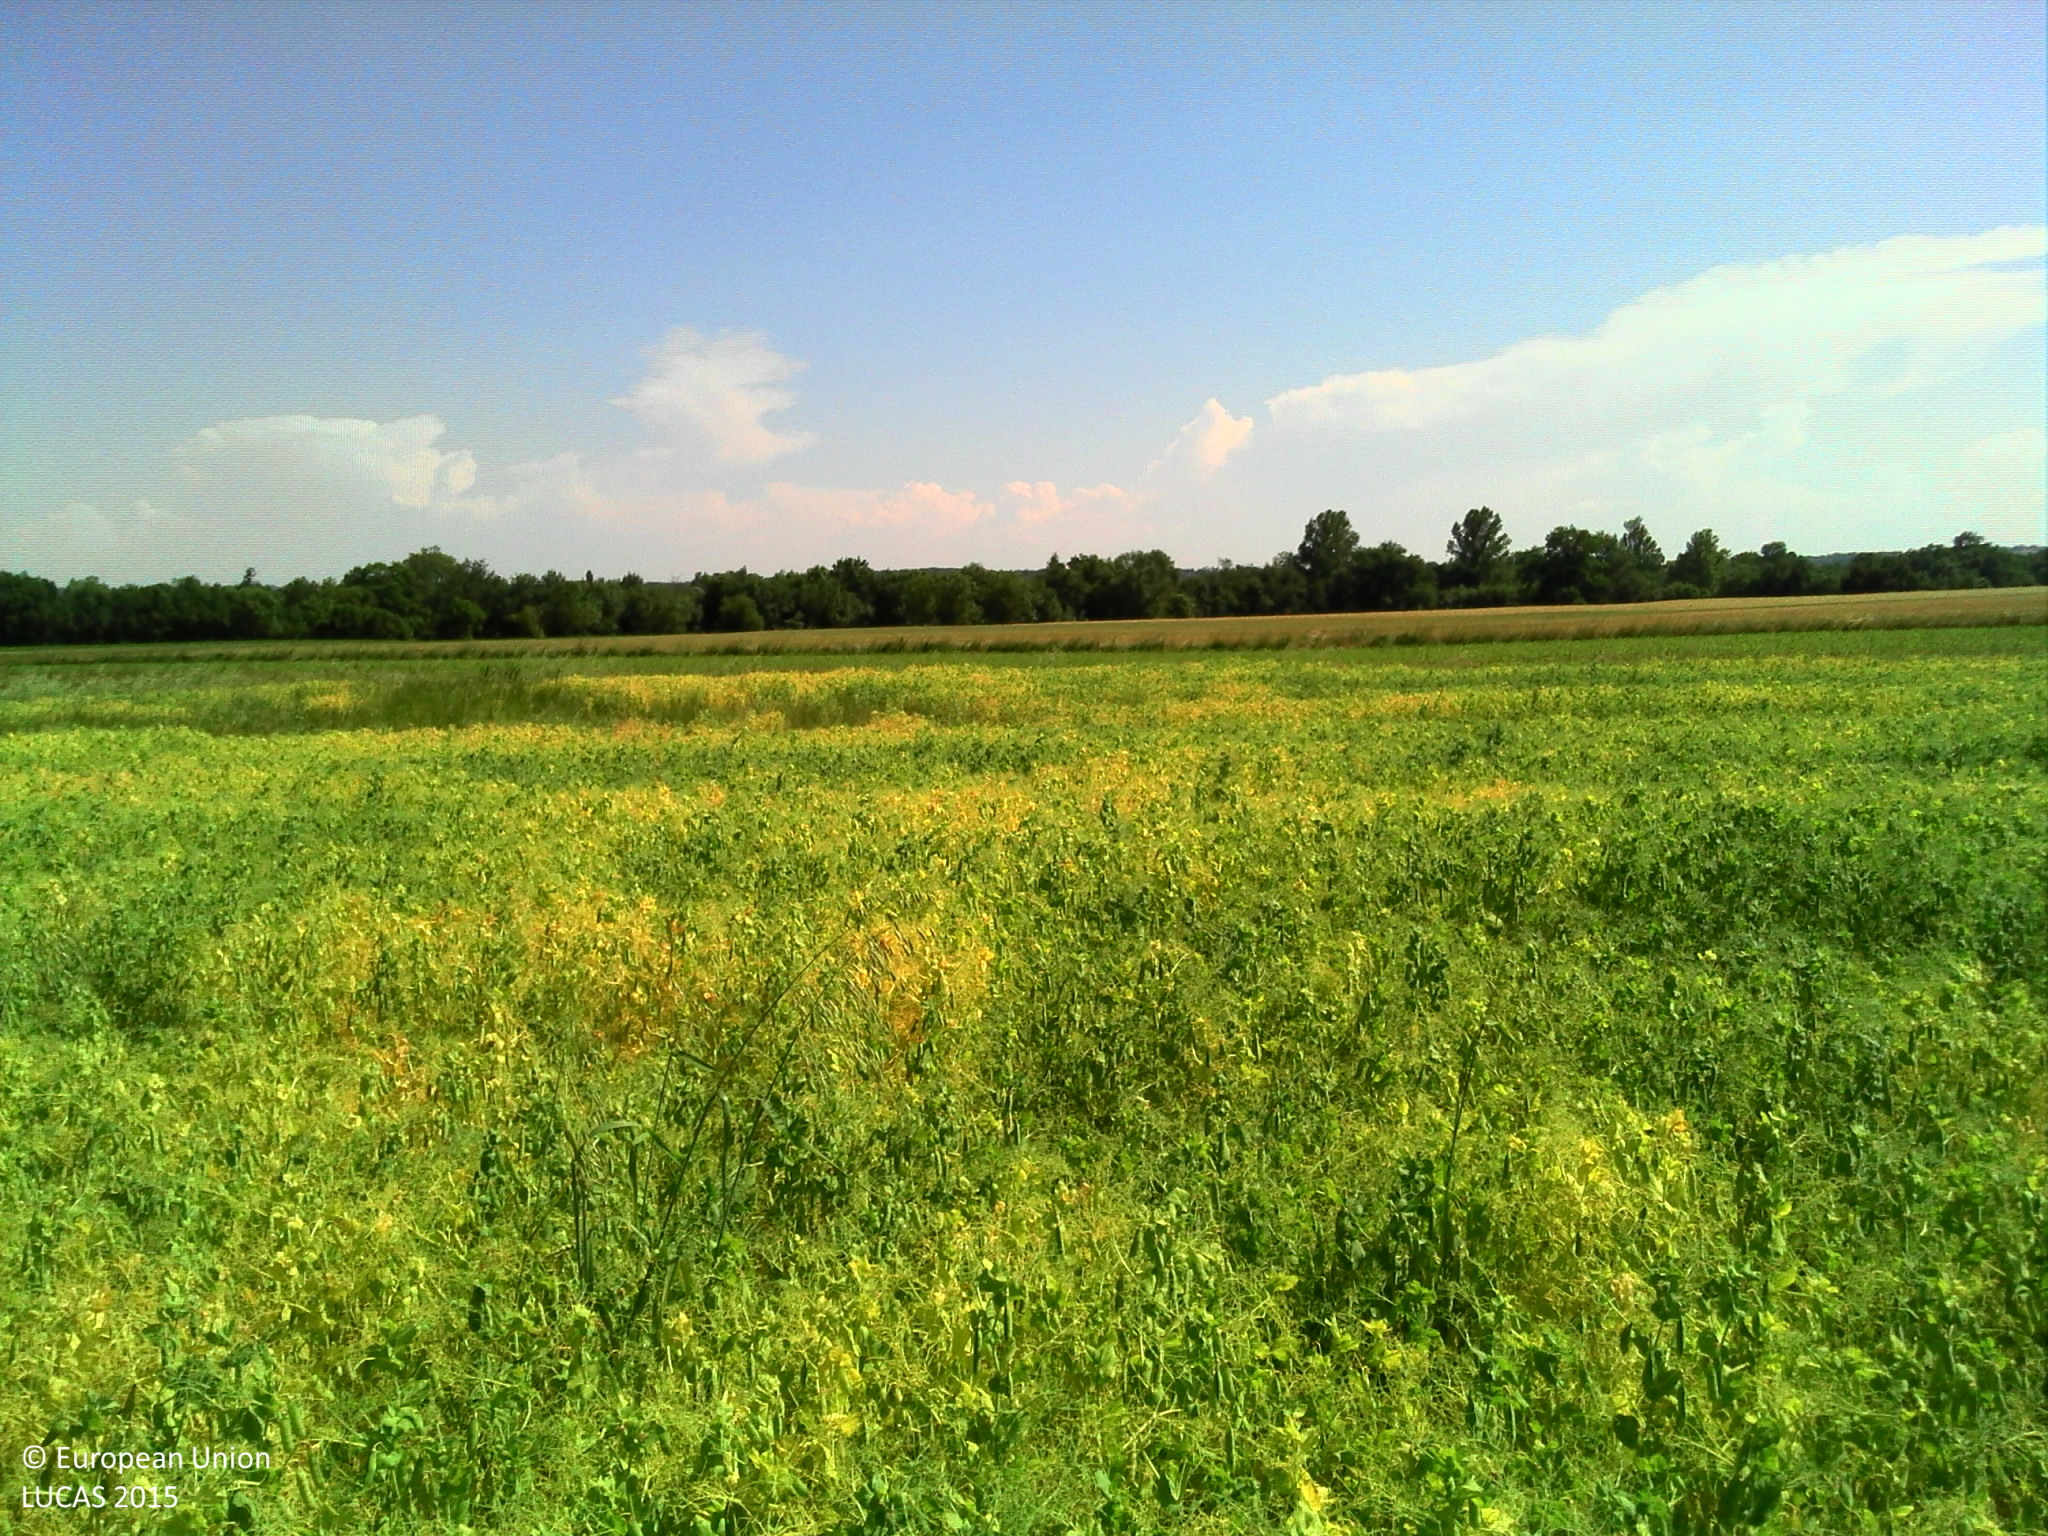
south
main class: Cropland
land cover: Dry pulses
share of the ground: > 75 %
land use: Agriculture (excluding fallow land and kitchen gardens)
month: June
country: FR
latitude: 43.8196
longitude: 0.6597
